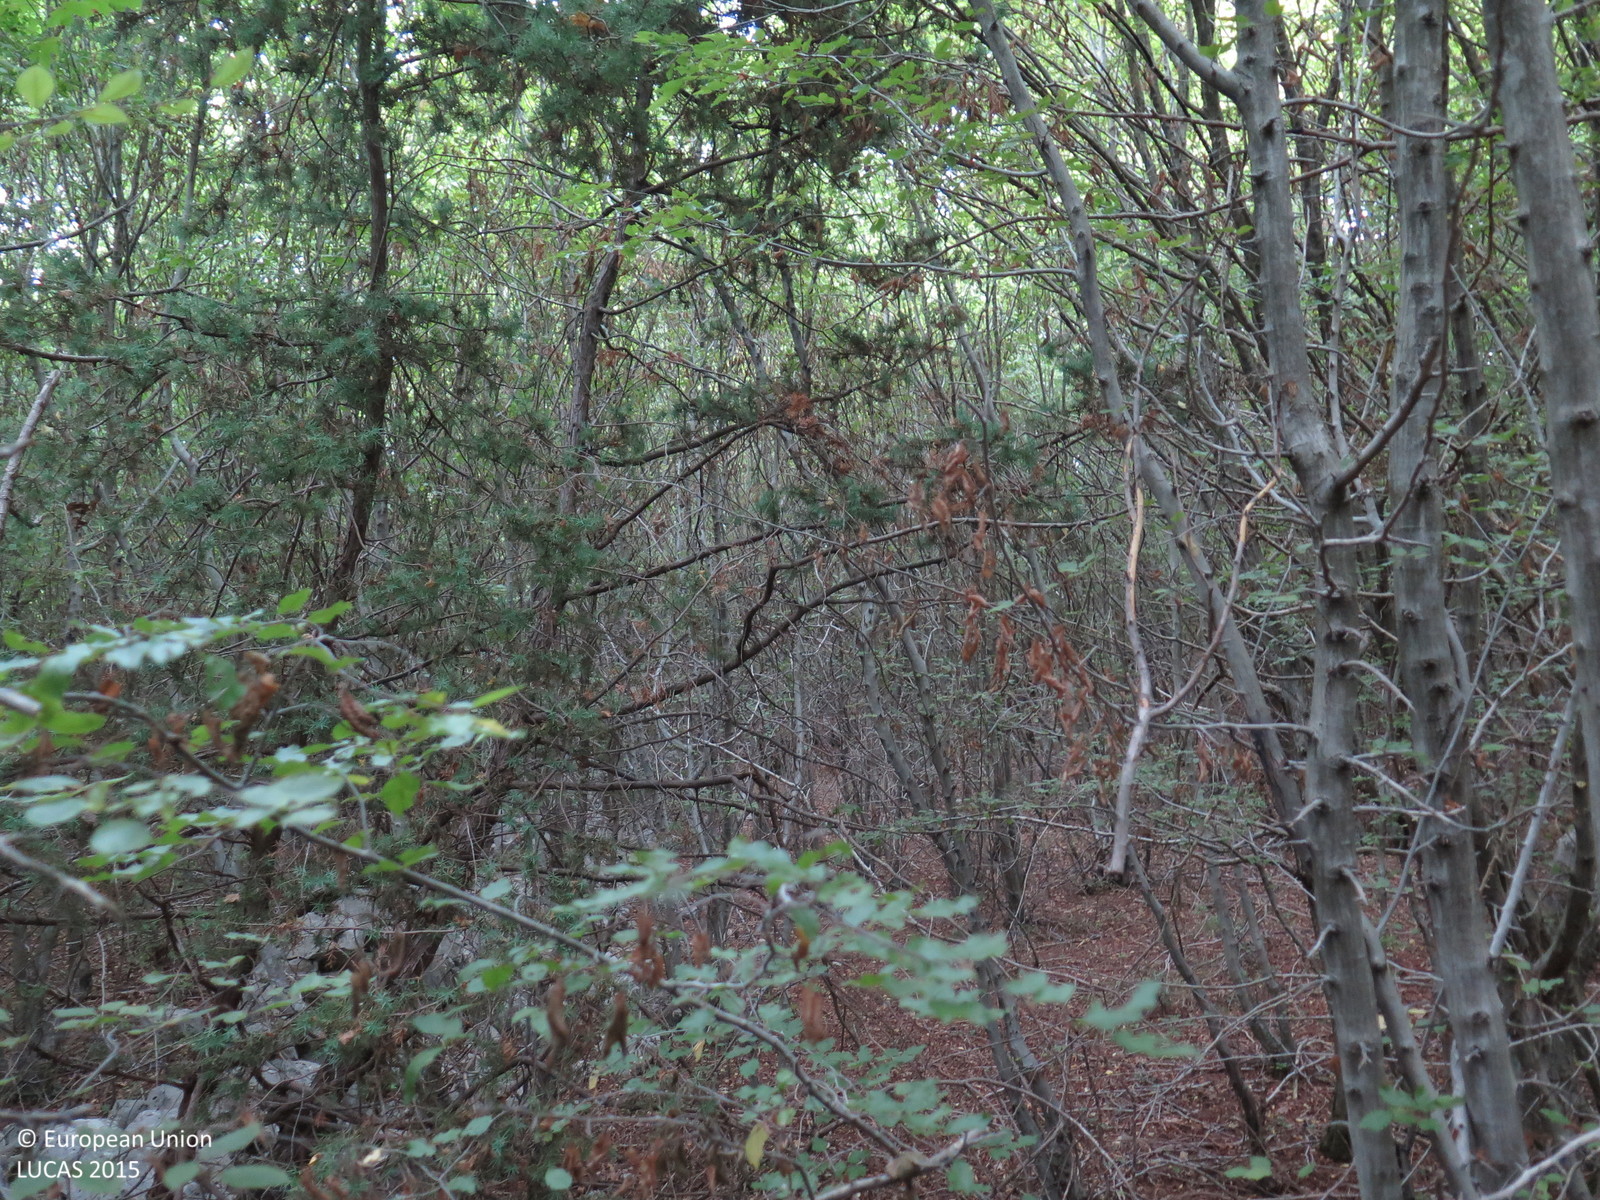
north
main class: Woodland
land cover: Broadleaved woodland
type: beech forest
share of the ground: > 75 %
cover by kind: broadleaved forest trees 100 %
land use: Forestry
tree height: > 5 m
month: August
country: HR
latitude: 45.0970
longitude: 14.6072
